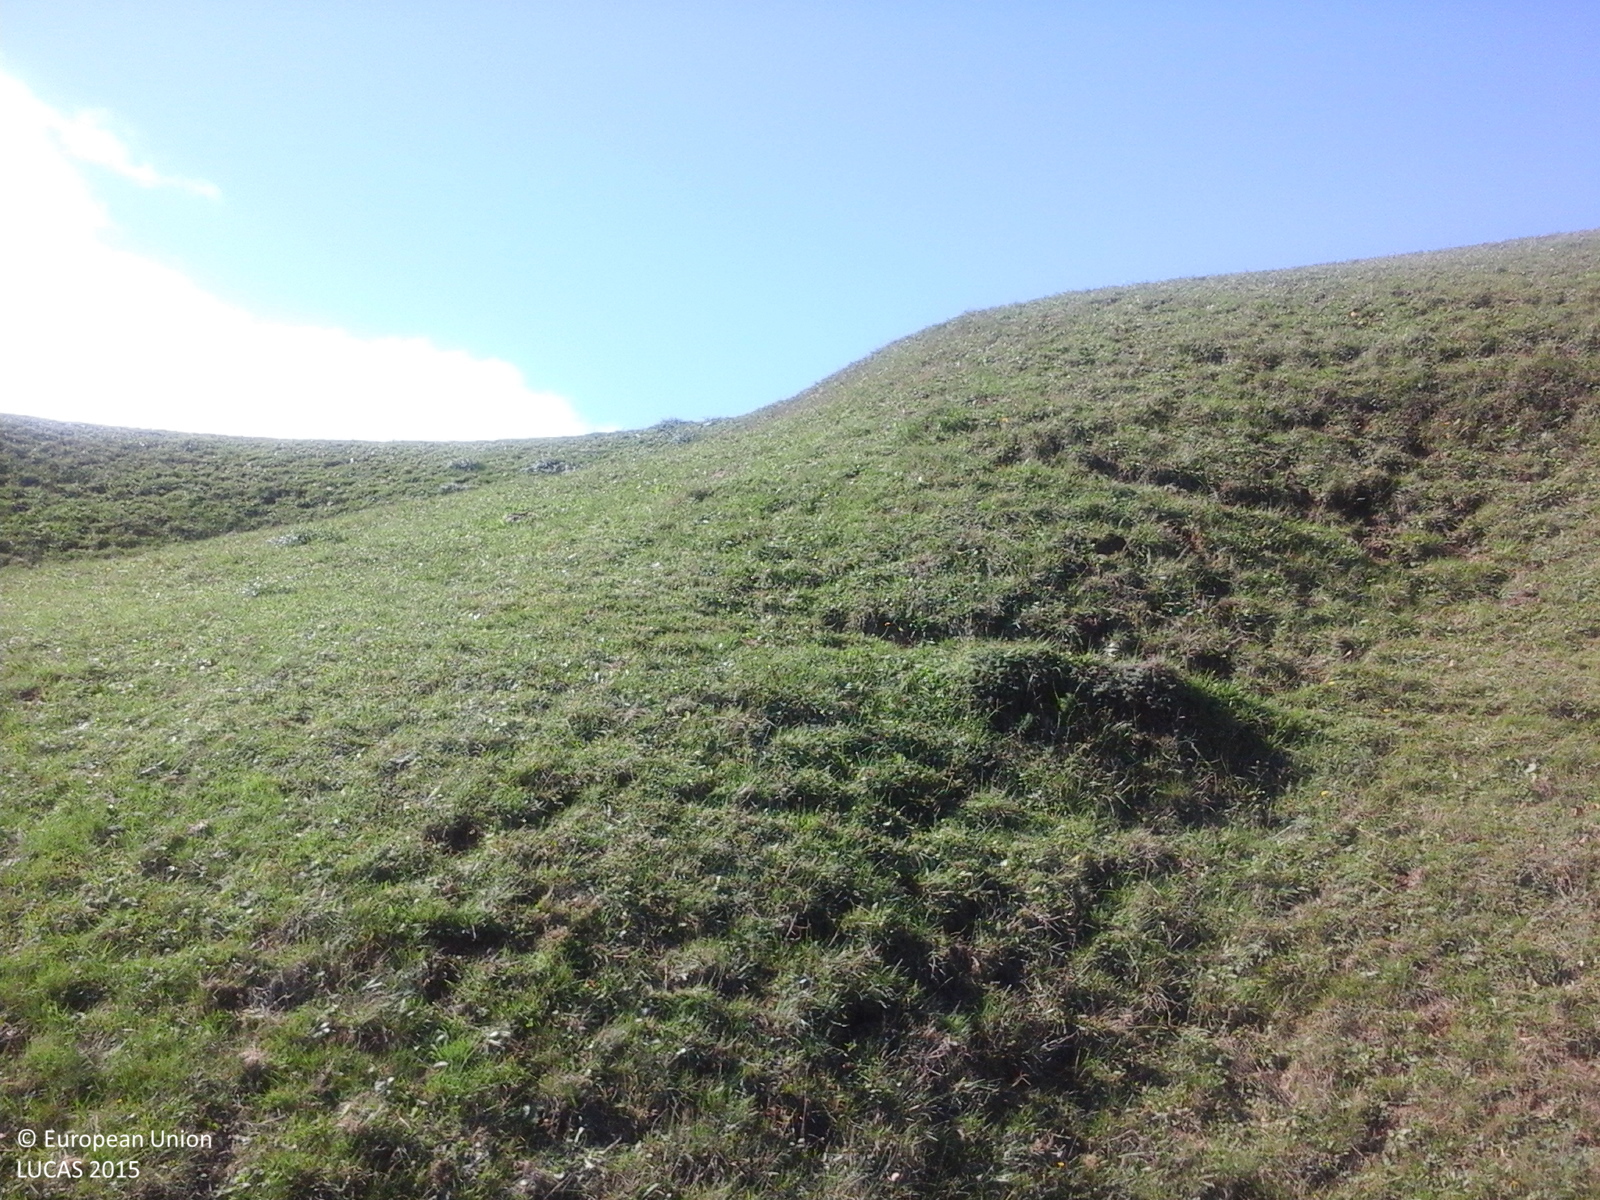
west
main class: Grassland
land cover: Grassland without tree/shrub cover
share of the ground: > 75 %
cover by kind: herbaceous plants 100 %
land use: Agriculture (excluding fallow land and kitchen gardens)
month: October
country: RO
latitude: 46.3947
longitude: 23.1310
